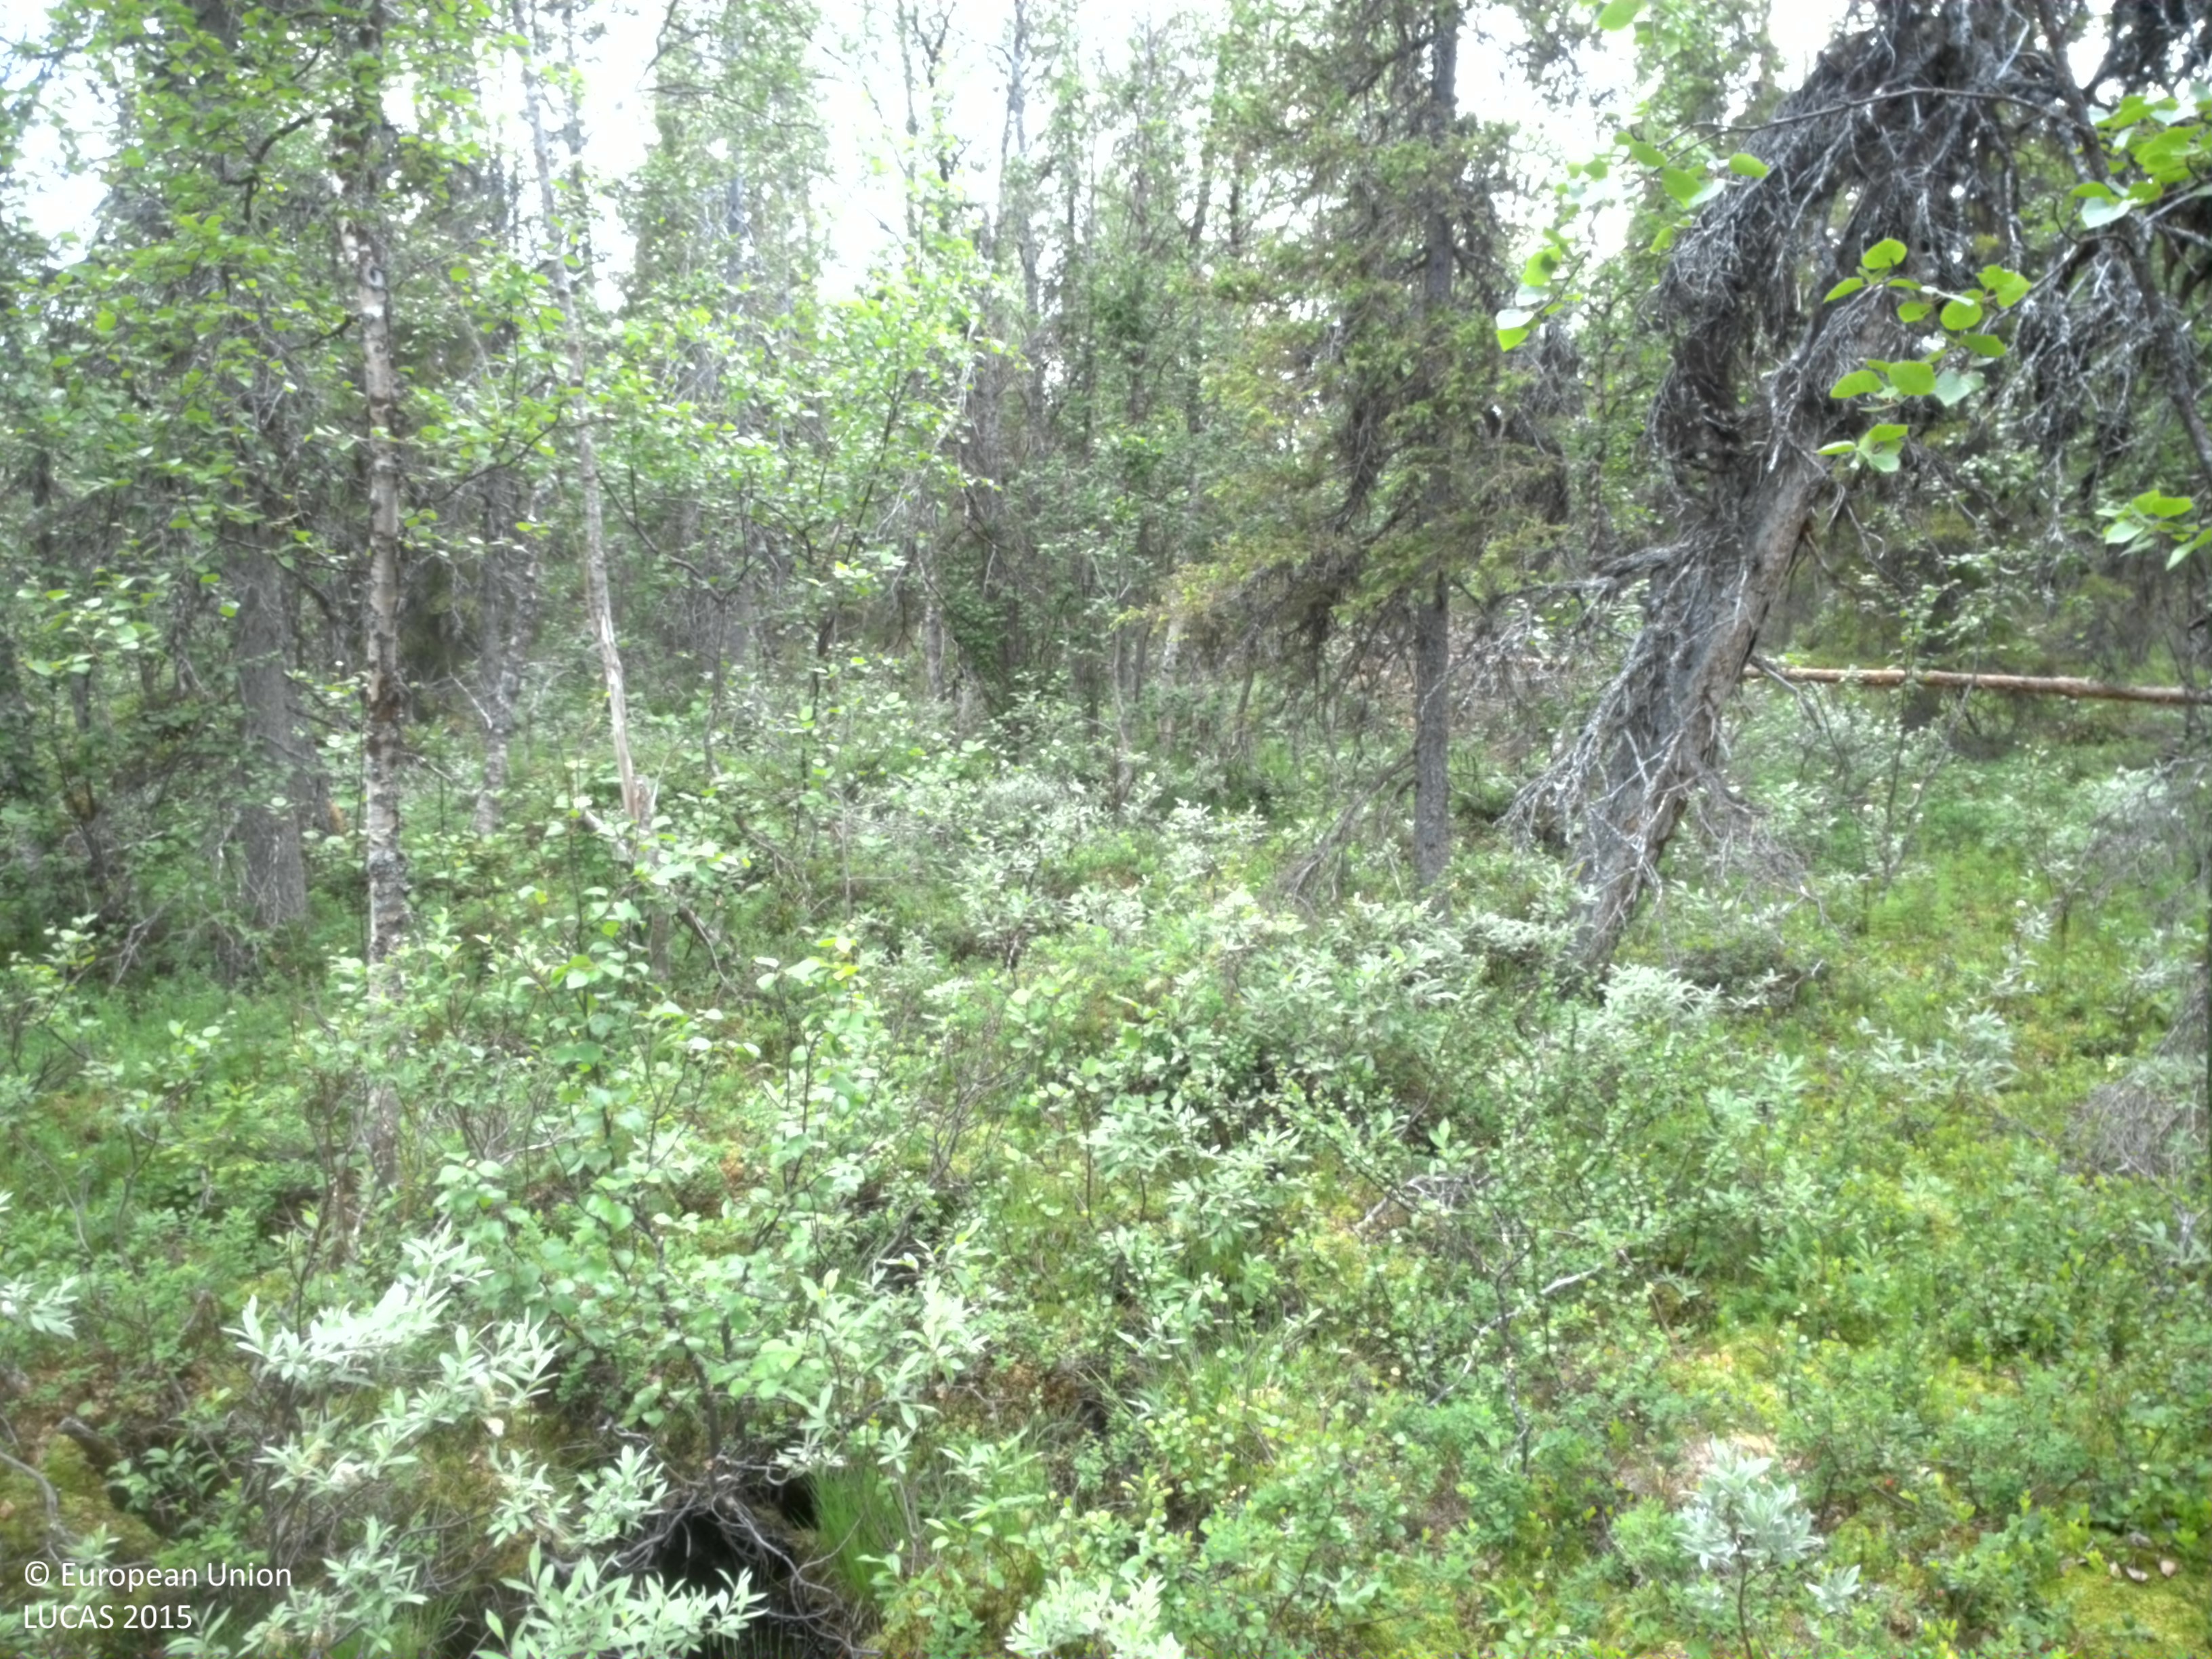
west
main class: Woodland
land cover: Spruce dominated mixed woodland
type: mire and swamp forests
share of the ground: 50 - 75 %
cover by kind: shrubs 40 %, coniferous forest trees 35 %, broadleaved forest trees 20 %, lichens and mosses 5 %
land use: Forestry
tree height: > 5 m
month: July
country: SE
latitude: 67.2688
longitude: 19.1506
